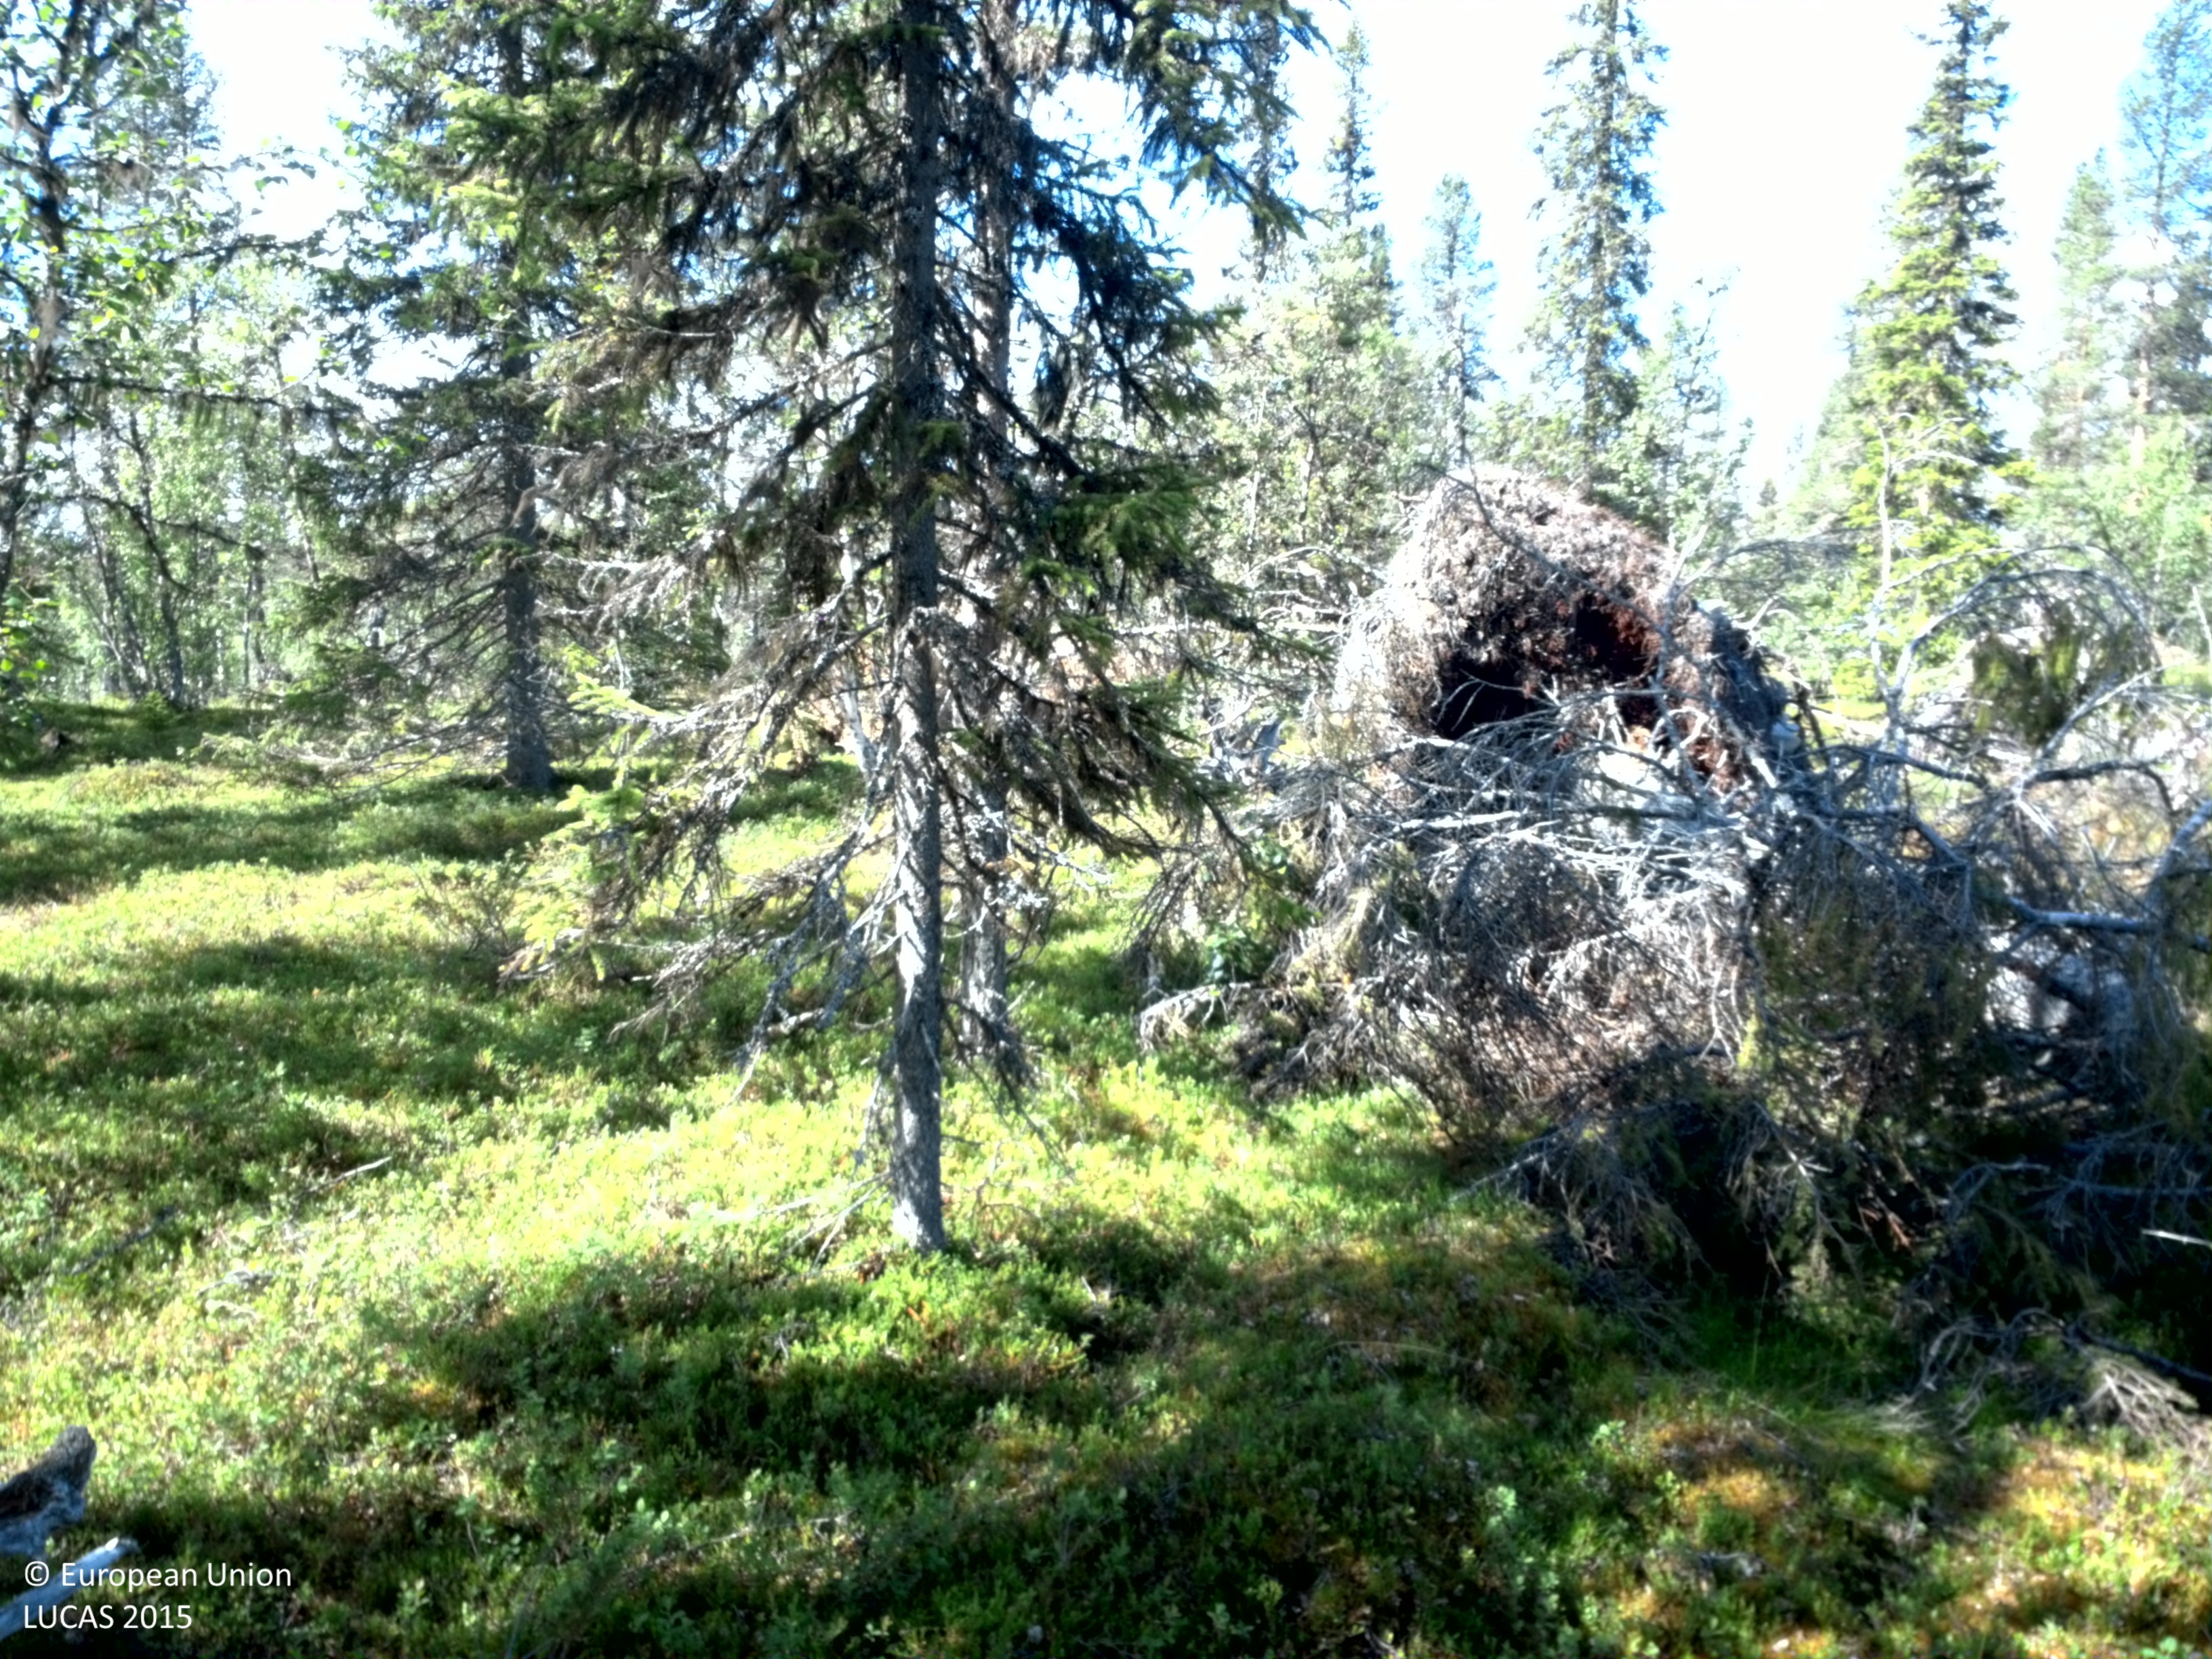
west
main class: Woodland
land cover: Spruce dominated mixed woodland
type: boreal forest
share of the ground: 10 - 25 %
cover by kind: shrubs 70 %, lichens and mosses 15 %, coniferous forest trees 10 %, broadleaved forest trees 5 %
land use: Forestry
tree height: > 5 m
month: August
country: SE
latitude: 64.8949
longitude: 16.1554
